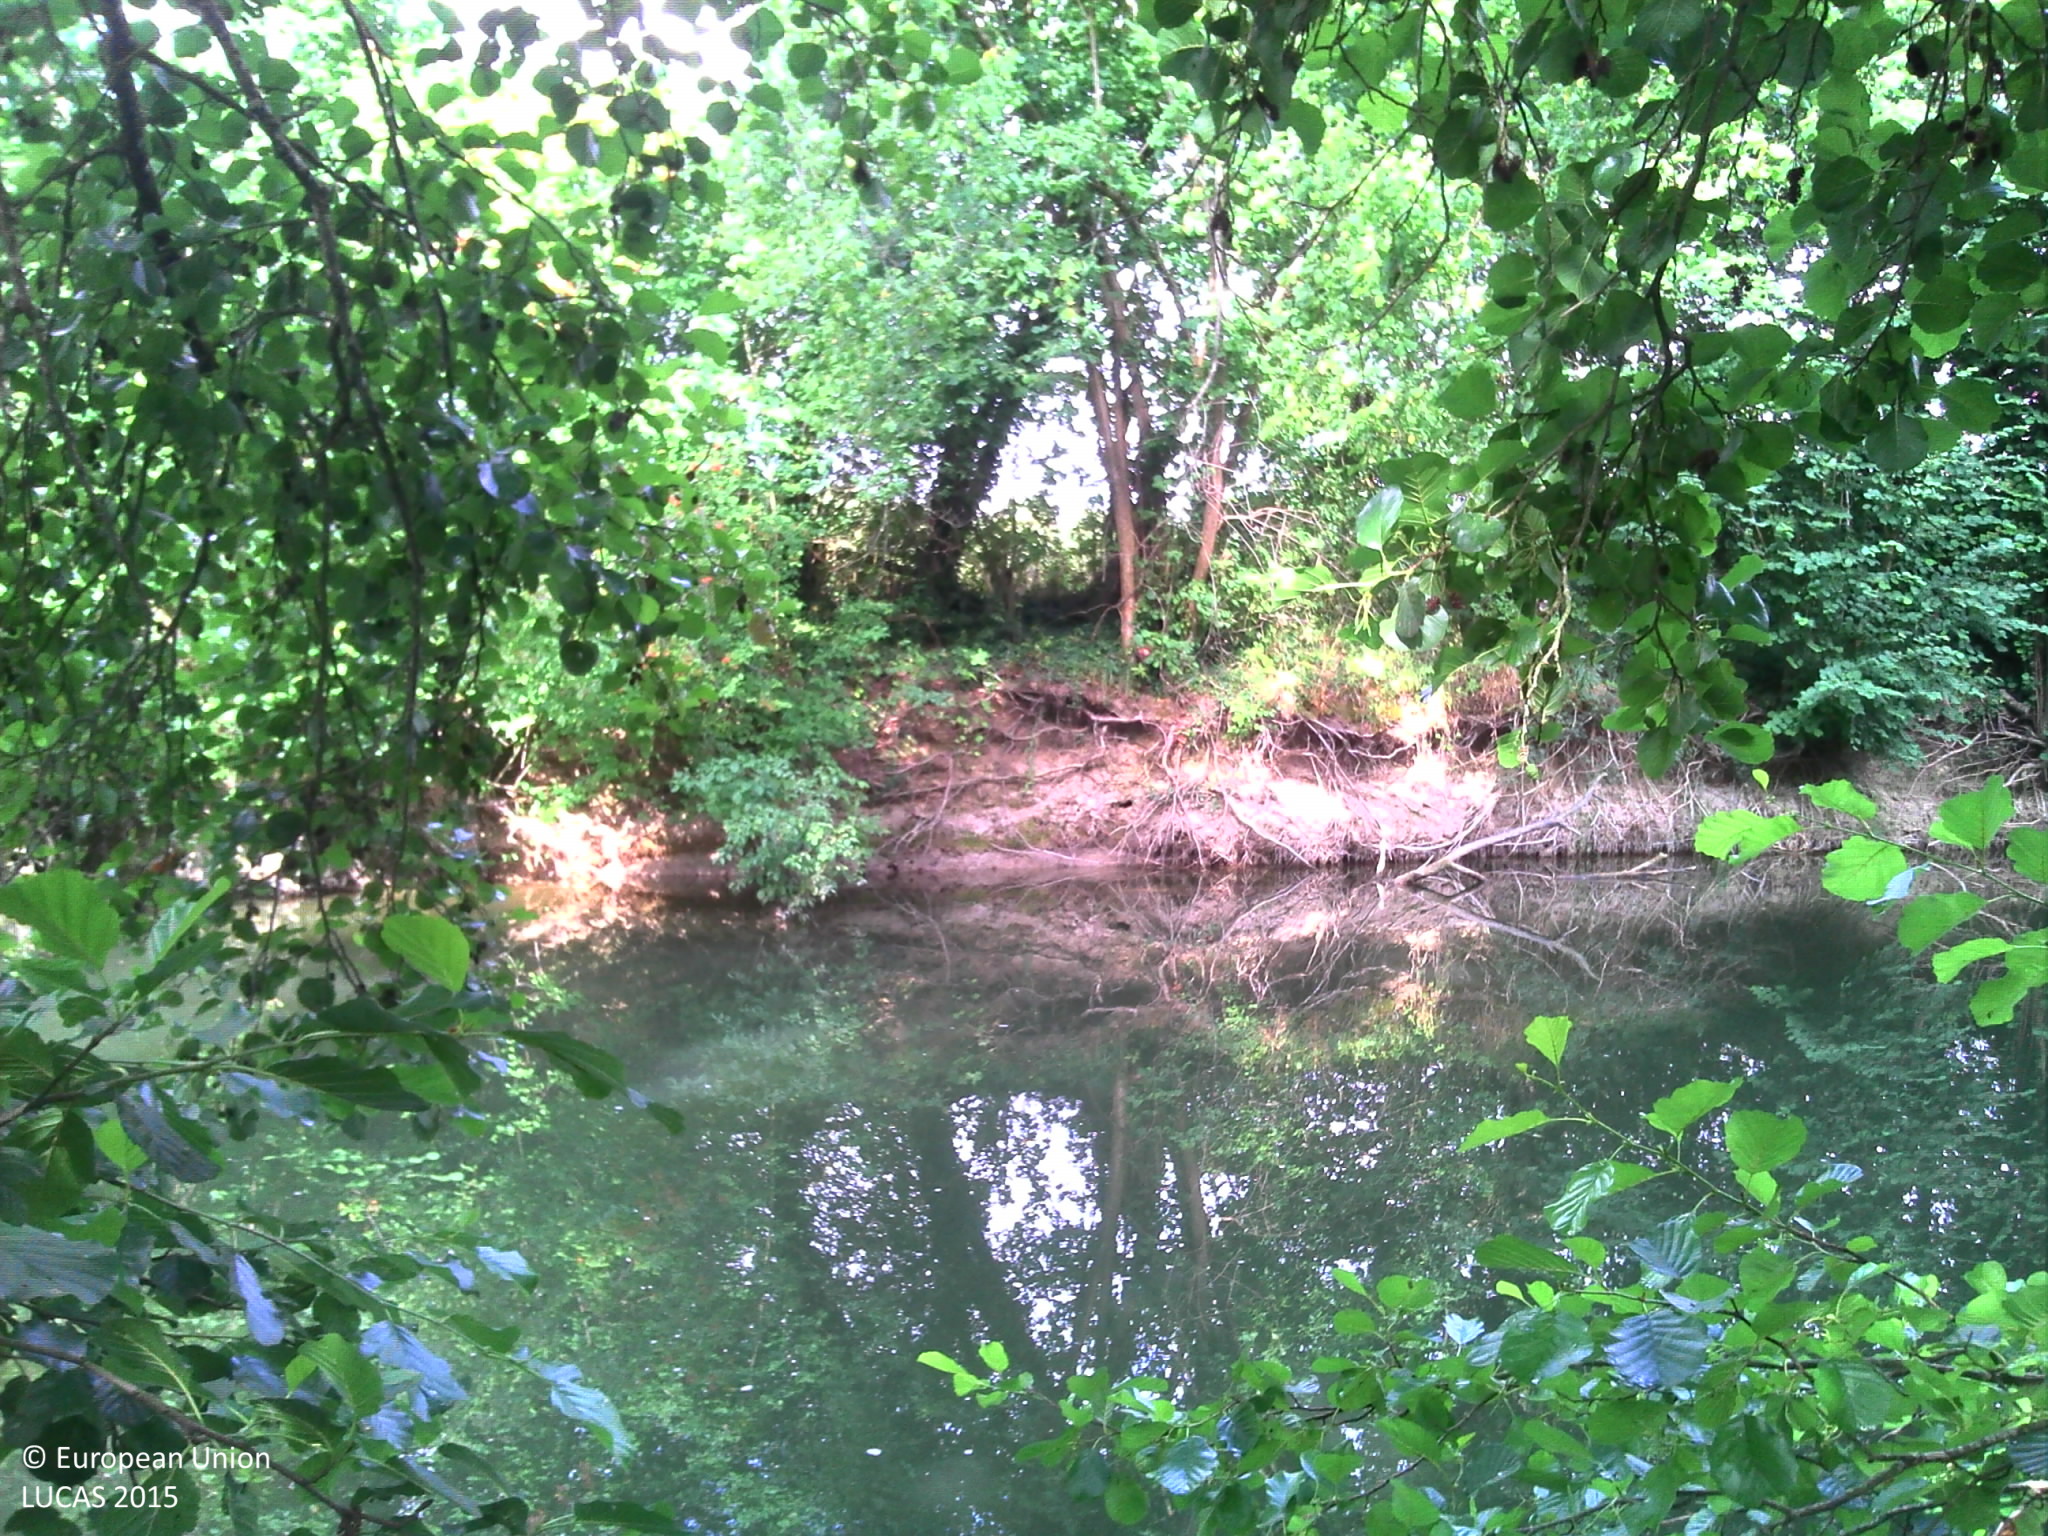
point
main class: Woodland
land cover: Broadleaved woodland
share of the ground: > 75 %
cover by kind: broadleaved forest trees 95 %, herbaceous plants 5 %
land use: Semi-natural and natural areas not in use
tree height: > 5 m
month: July
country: FR
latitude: 49.2116
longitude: 5.0423
